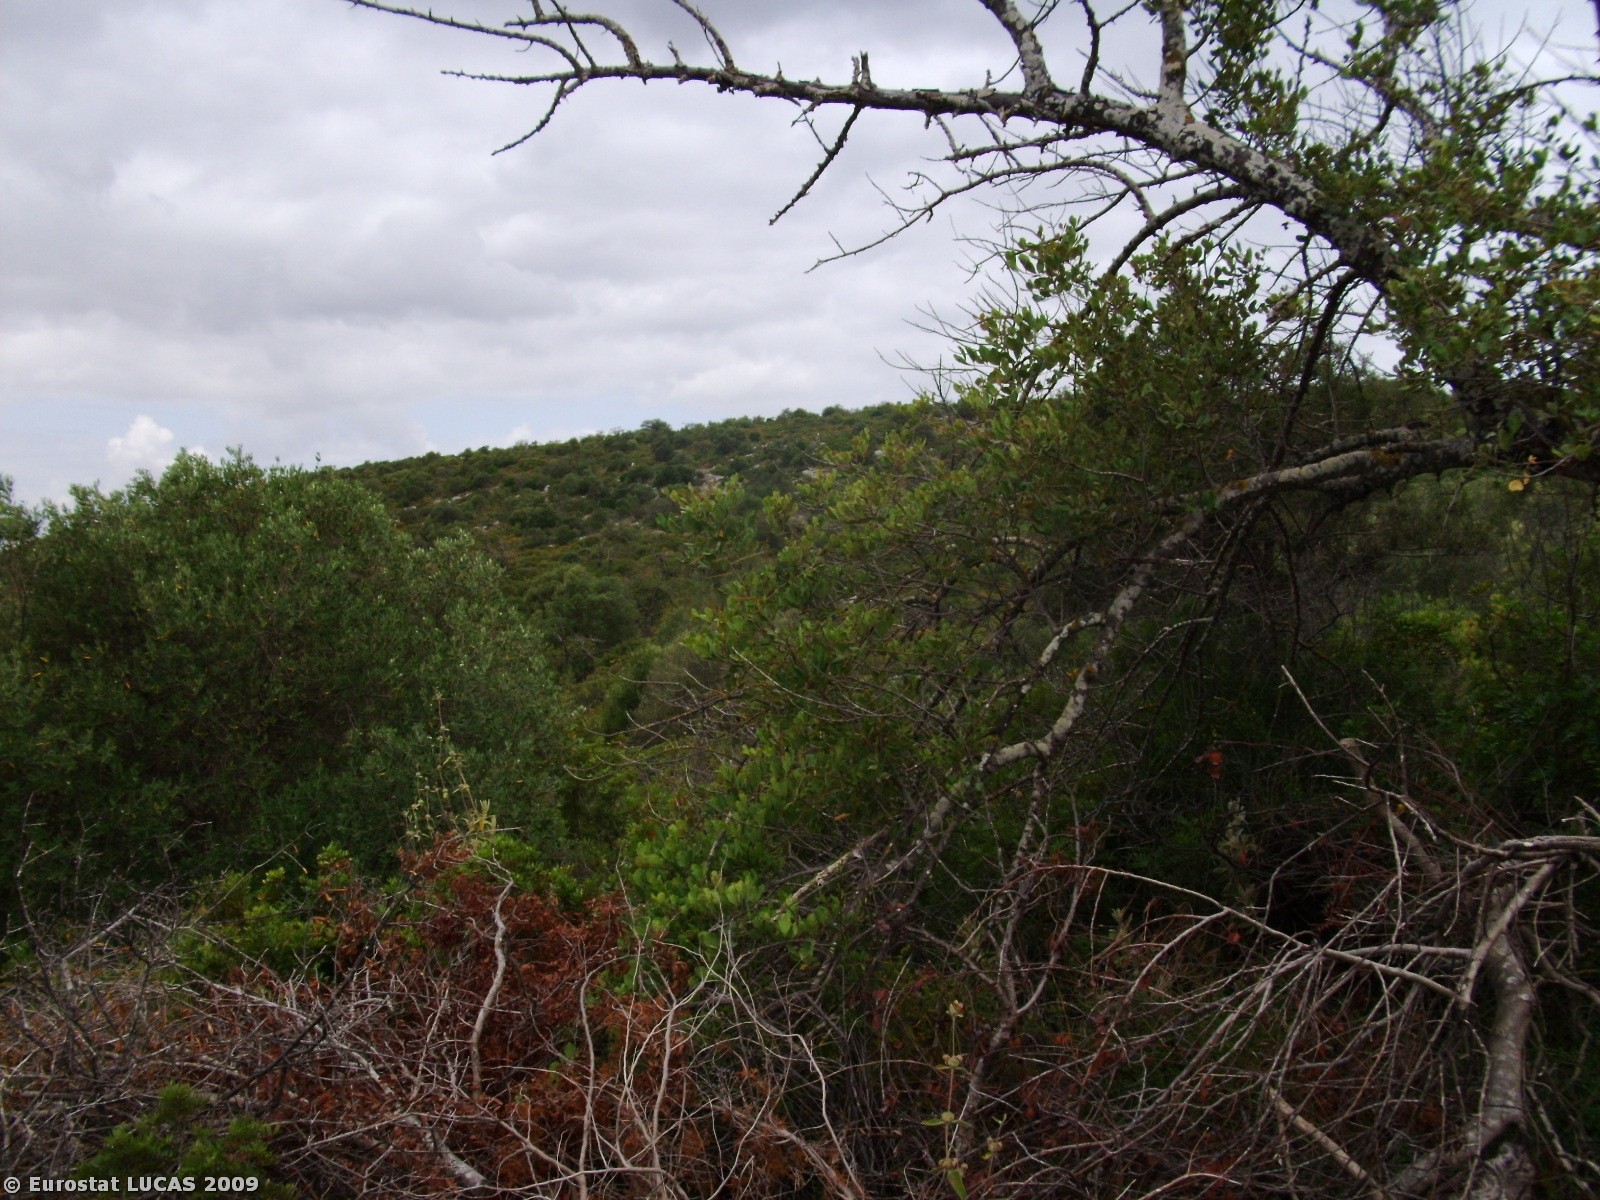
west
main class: Shrubland
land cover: Shrubland with sparse tree cover
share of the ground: 50 - 75 %
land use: Unused
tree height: > 5 m
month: May
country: PT
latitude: 37.1419
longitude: -8.1068
